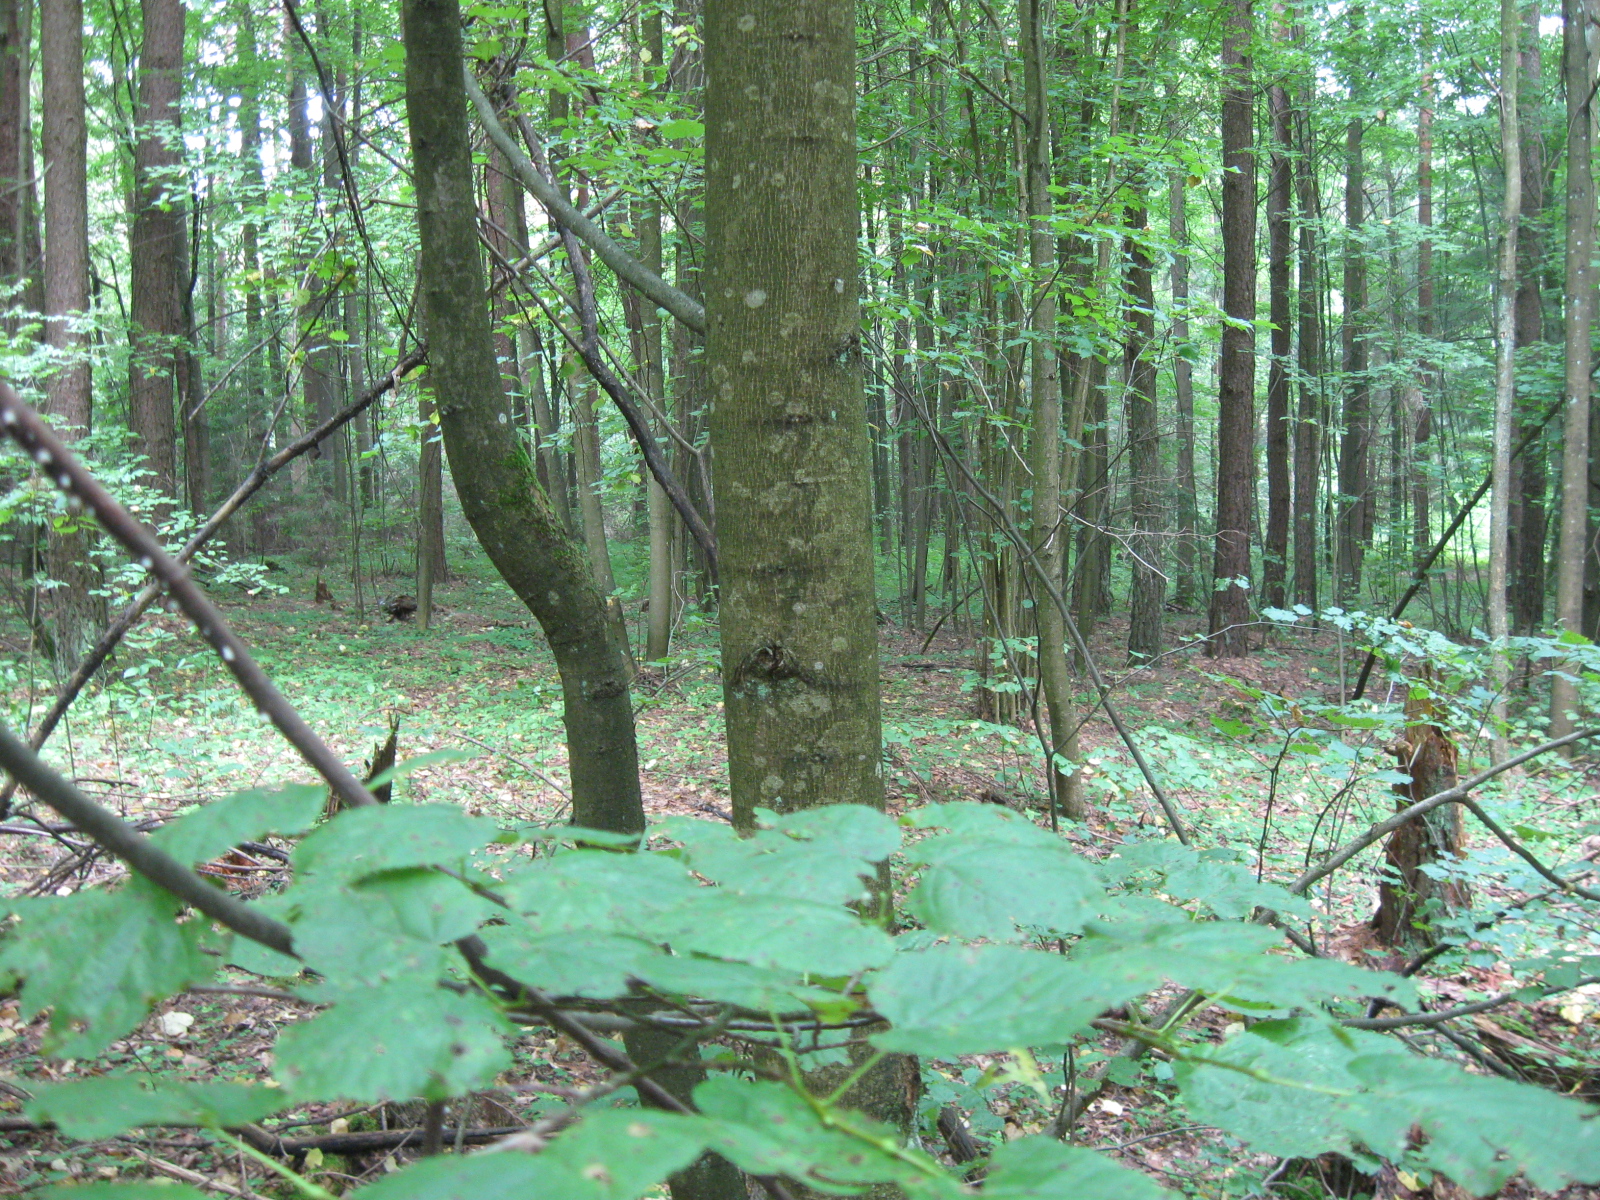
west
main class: Woodland
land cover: Pine dominated mixed woodland
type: hemiboreal forest and nemoral coniferous forest and mixed broadleaved-coniferous forest
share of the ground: > 75 %
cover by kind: broadleaved forest trees 45 %, coniferous forest trees 40 %, unconsolidated bare surface 10 %, herbaceous plants 5 %
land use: Forestry
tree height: > 5 m
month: July
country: LT
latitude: 55.0196
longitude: 23.6119
